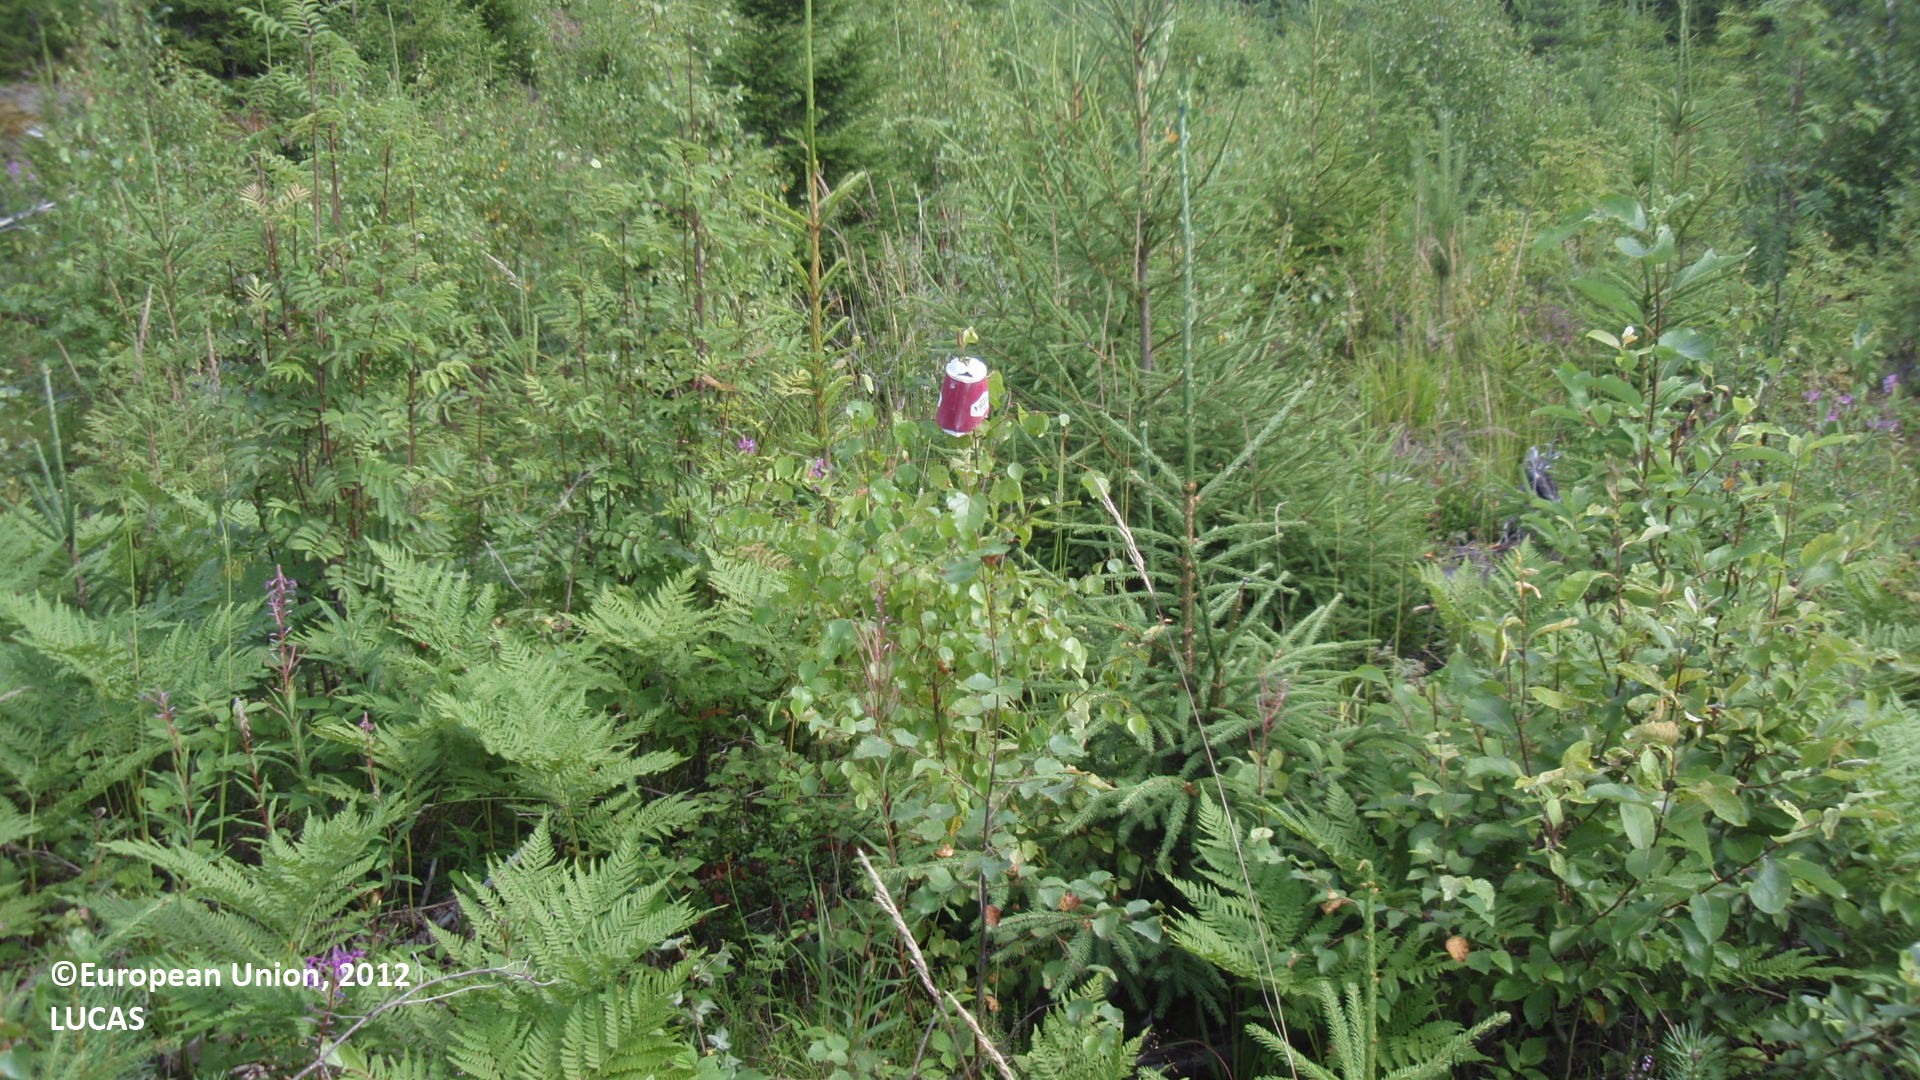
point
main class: Shrubland
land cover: Shrubland with sparse tree cover
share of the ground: > 75 %
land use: Forestry
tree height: < 5 m
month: July
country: FI
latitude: 61.4313
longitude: 28.9174
